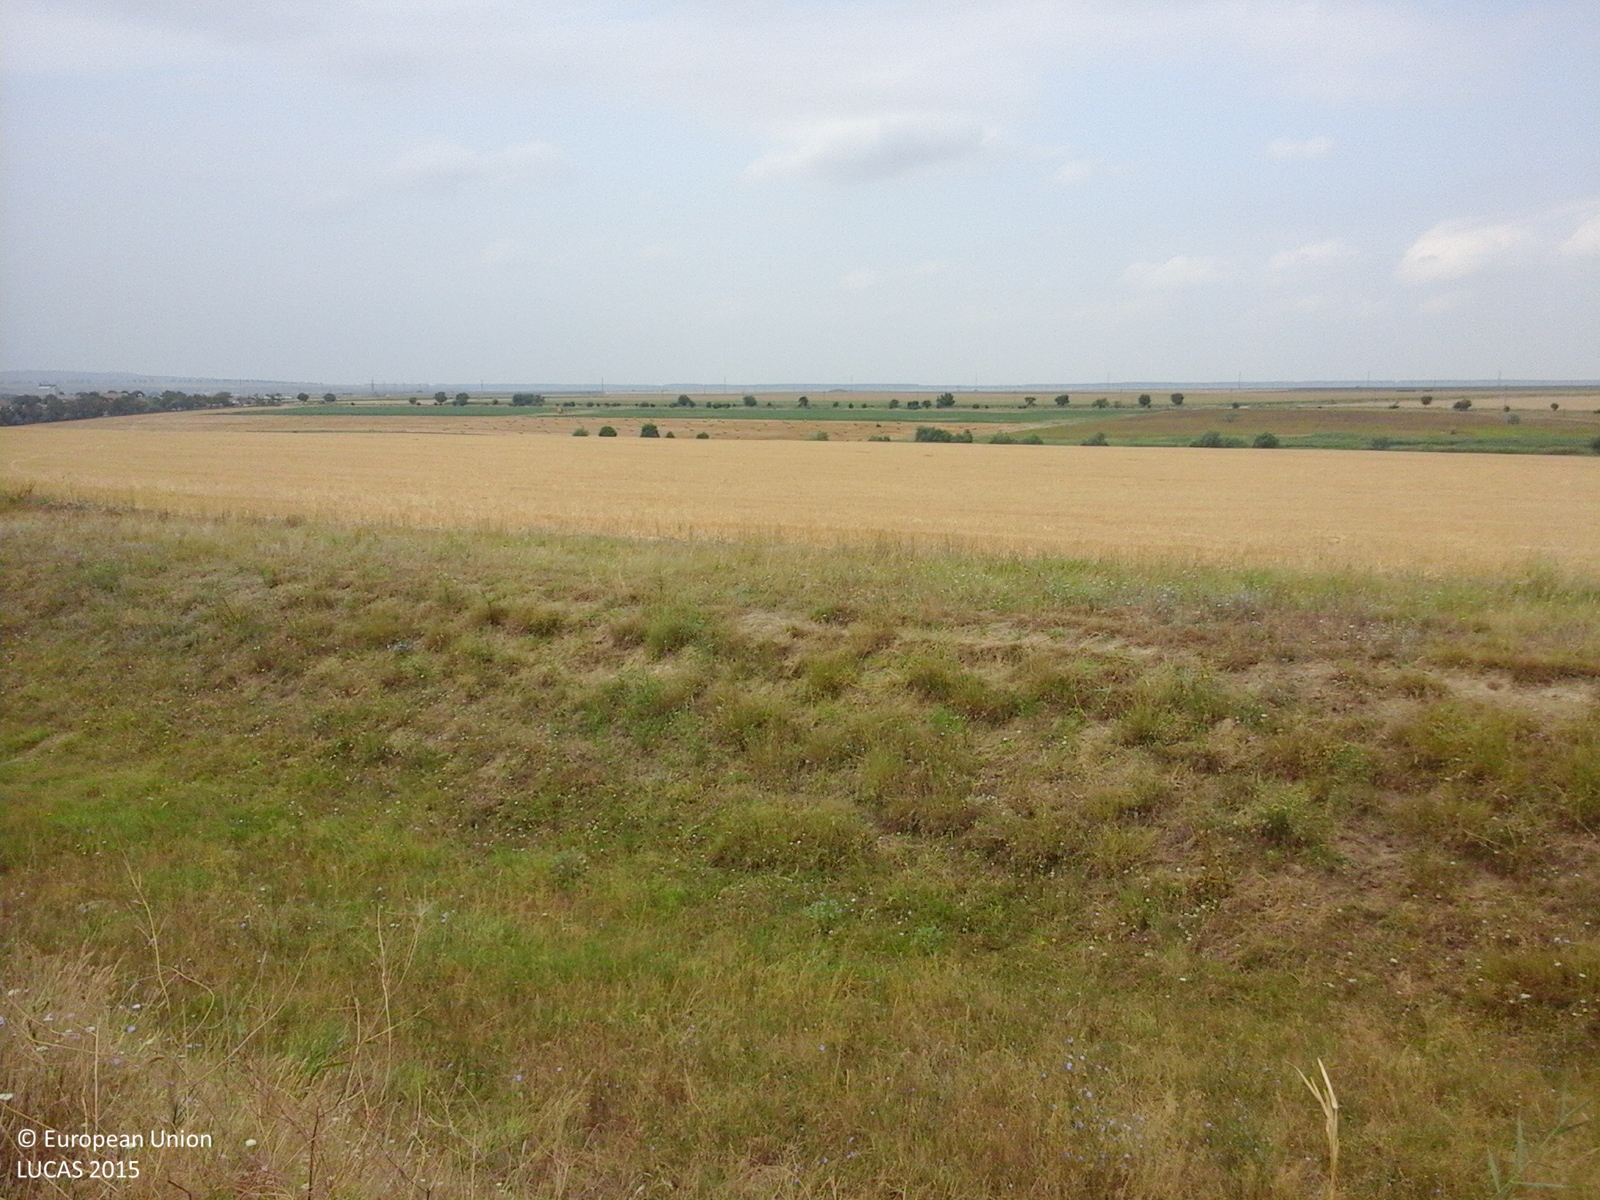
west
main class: Grassland
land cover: Grassland without tree/shrub cover
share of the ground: > 75 %
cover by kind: herbaceous plants 100 %
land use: Agriculture (excluding fallow land and kitchen gardens)
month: July
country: RO
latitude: 45.0558
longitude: 28.2676
